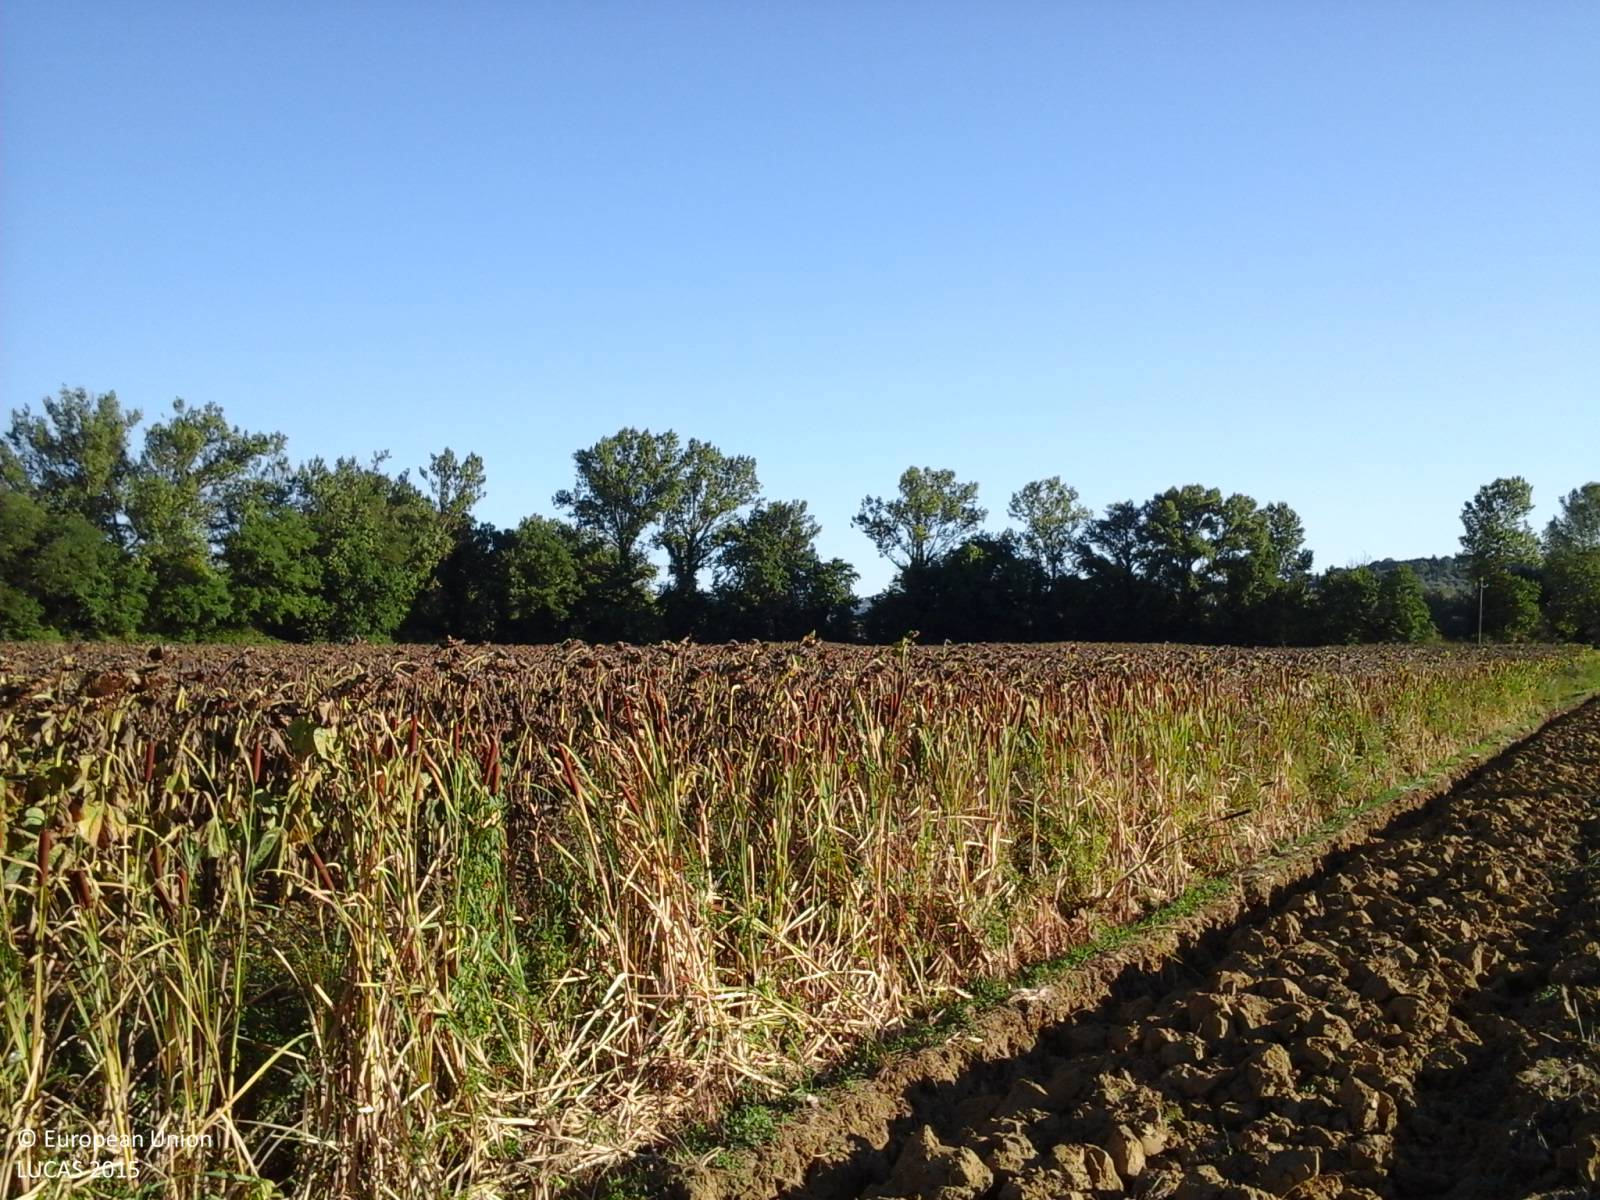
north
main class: Cropland
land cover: Common wheat
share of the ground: < 10 %
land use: Agriculture (excluding fallow land and kitchen gardens)
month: September
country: IT
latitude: 43.0600
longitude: 12.3628
